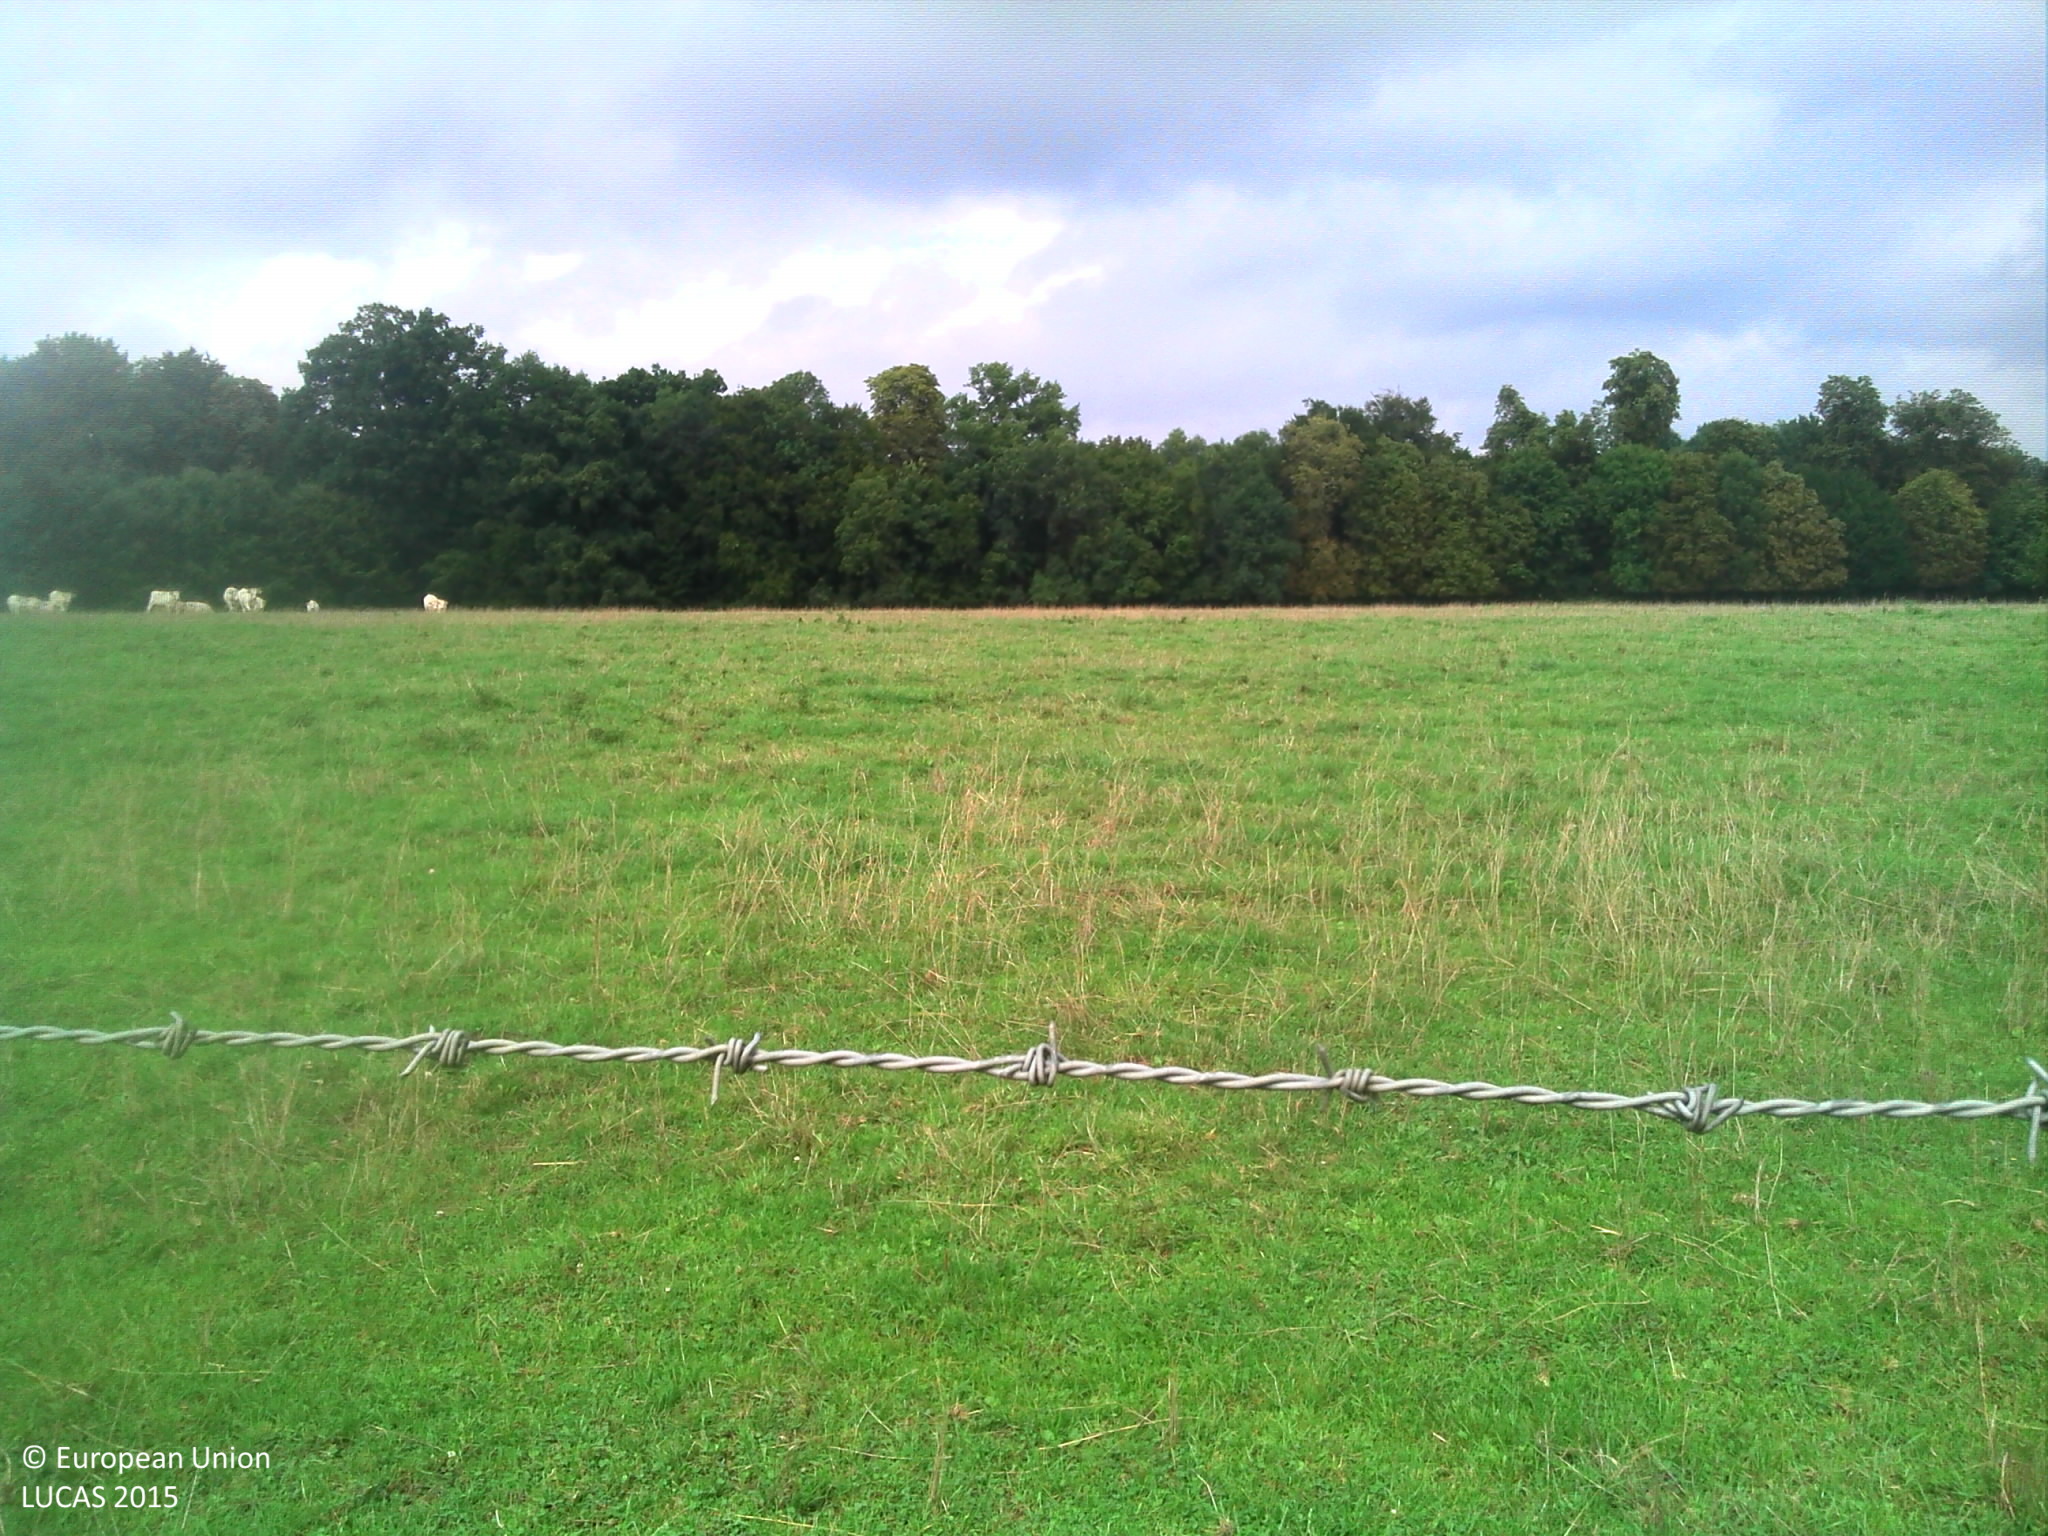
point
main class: Grassland
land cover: Grassland without tree/shrub cover
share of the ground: > 75 %
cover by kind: herbaceous plants 100 %
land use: Agriculture (excluding fallow land and kitchen gardens)
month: August
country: FR
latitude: 48.5067
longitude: 0.5686
